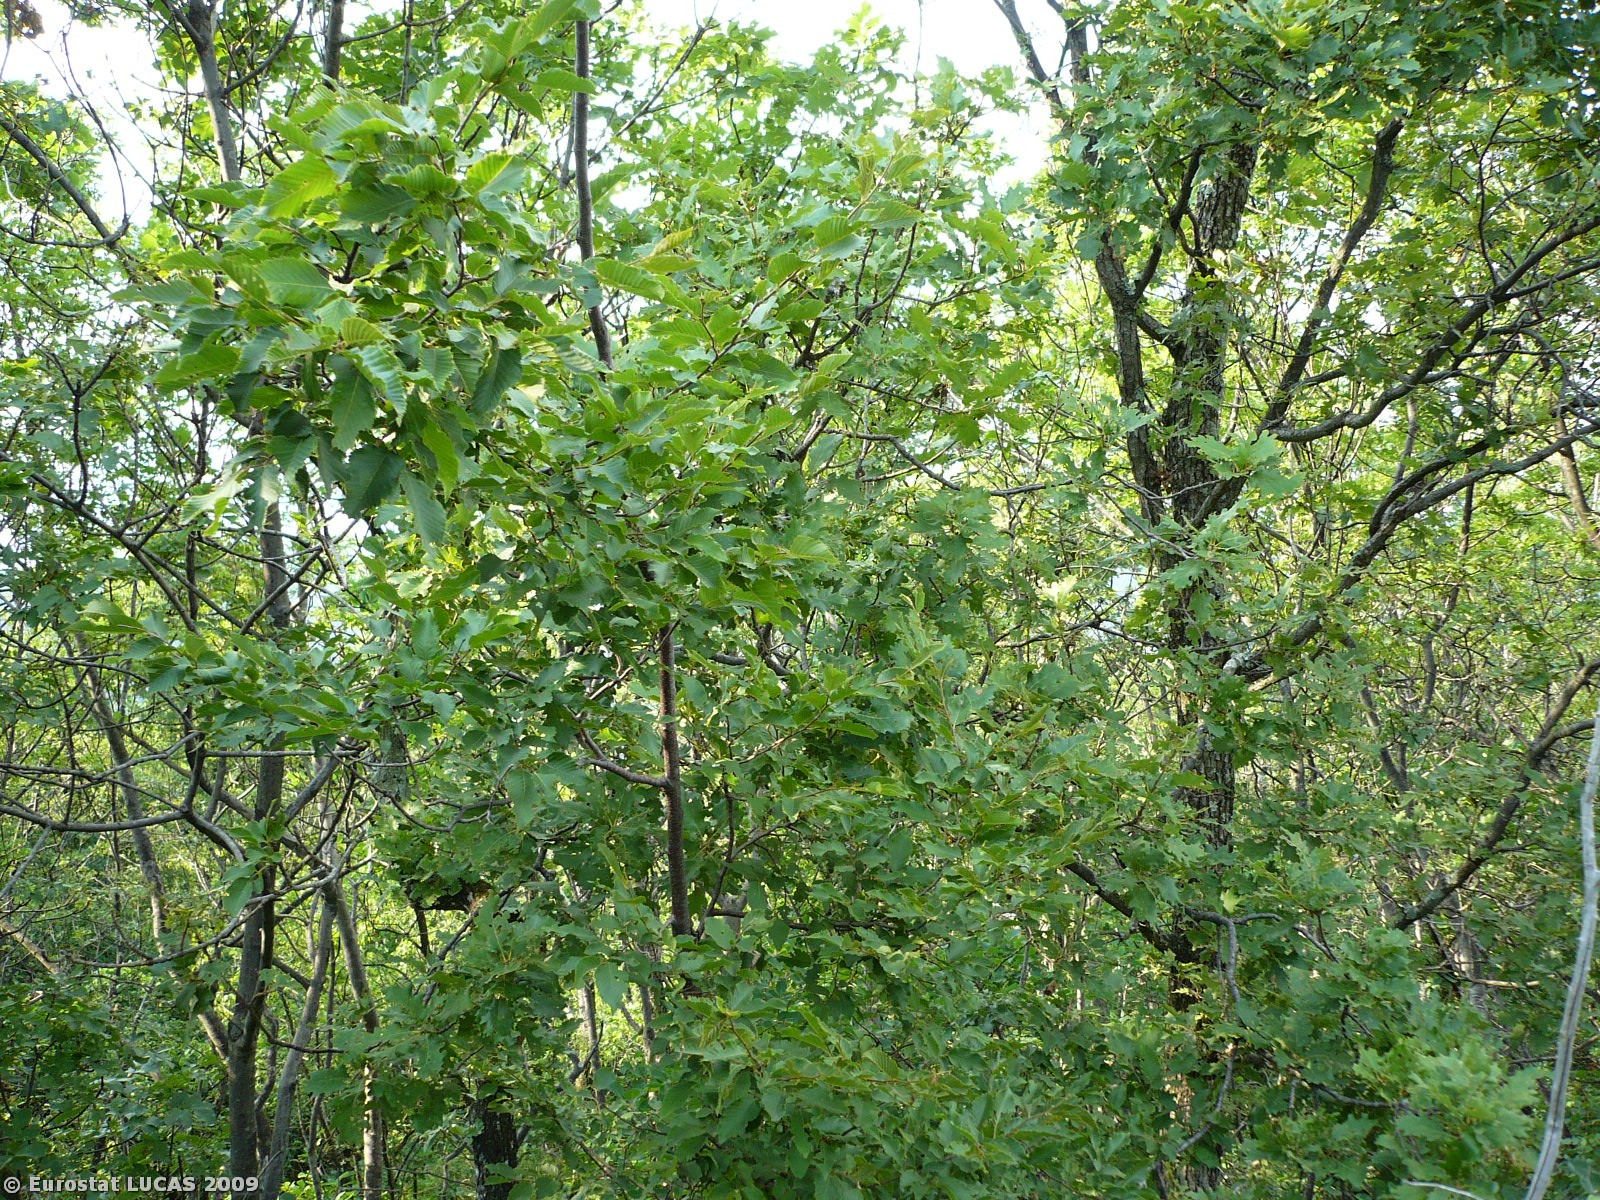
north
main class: Woodland
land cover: Broadleaved woodland
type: thermophilous deciduous forest
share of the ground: > 75 %
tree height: > 5 m
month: July
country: SI
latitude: 45.8016
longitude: 13.6628
